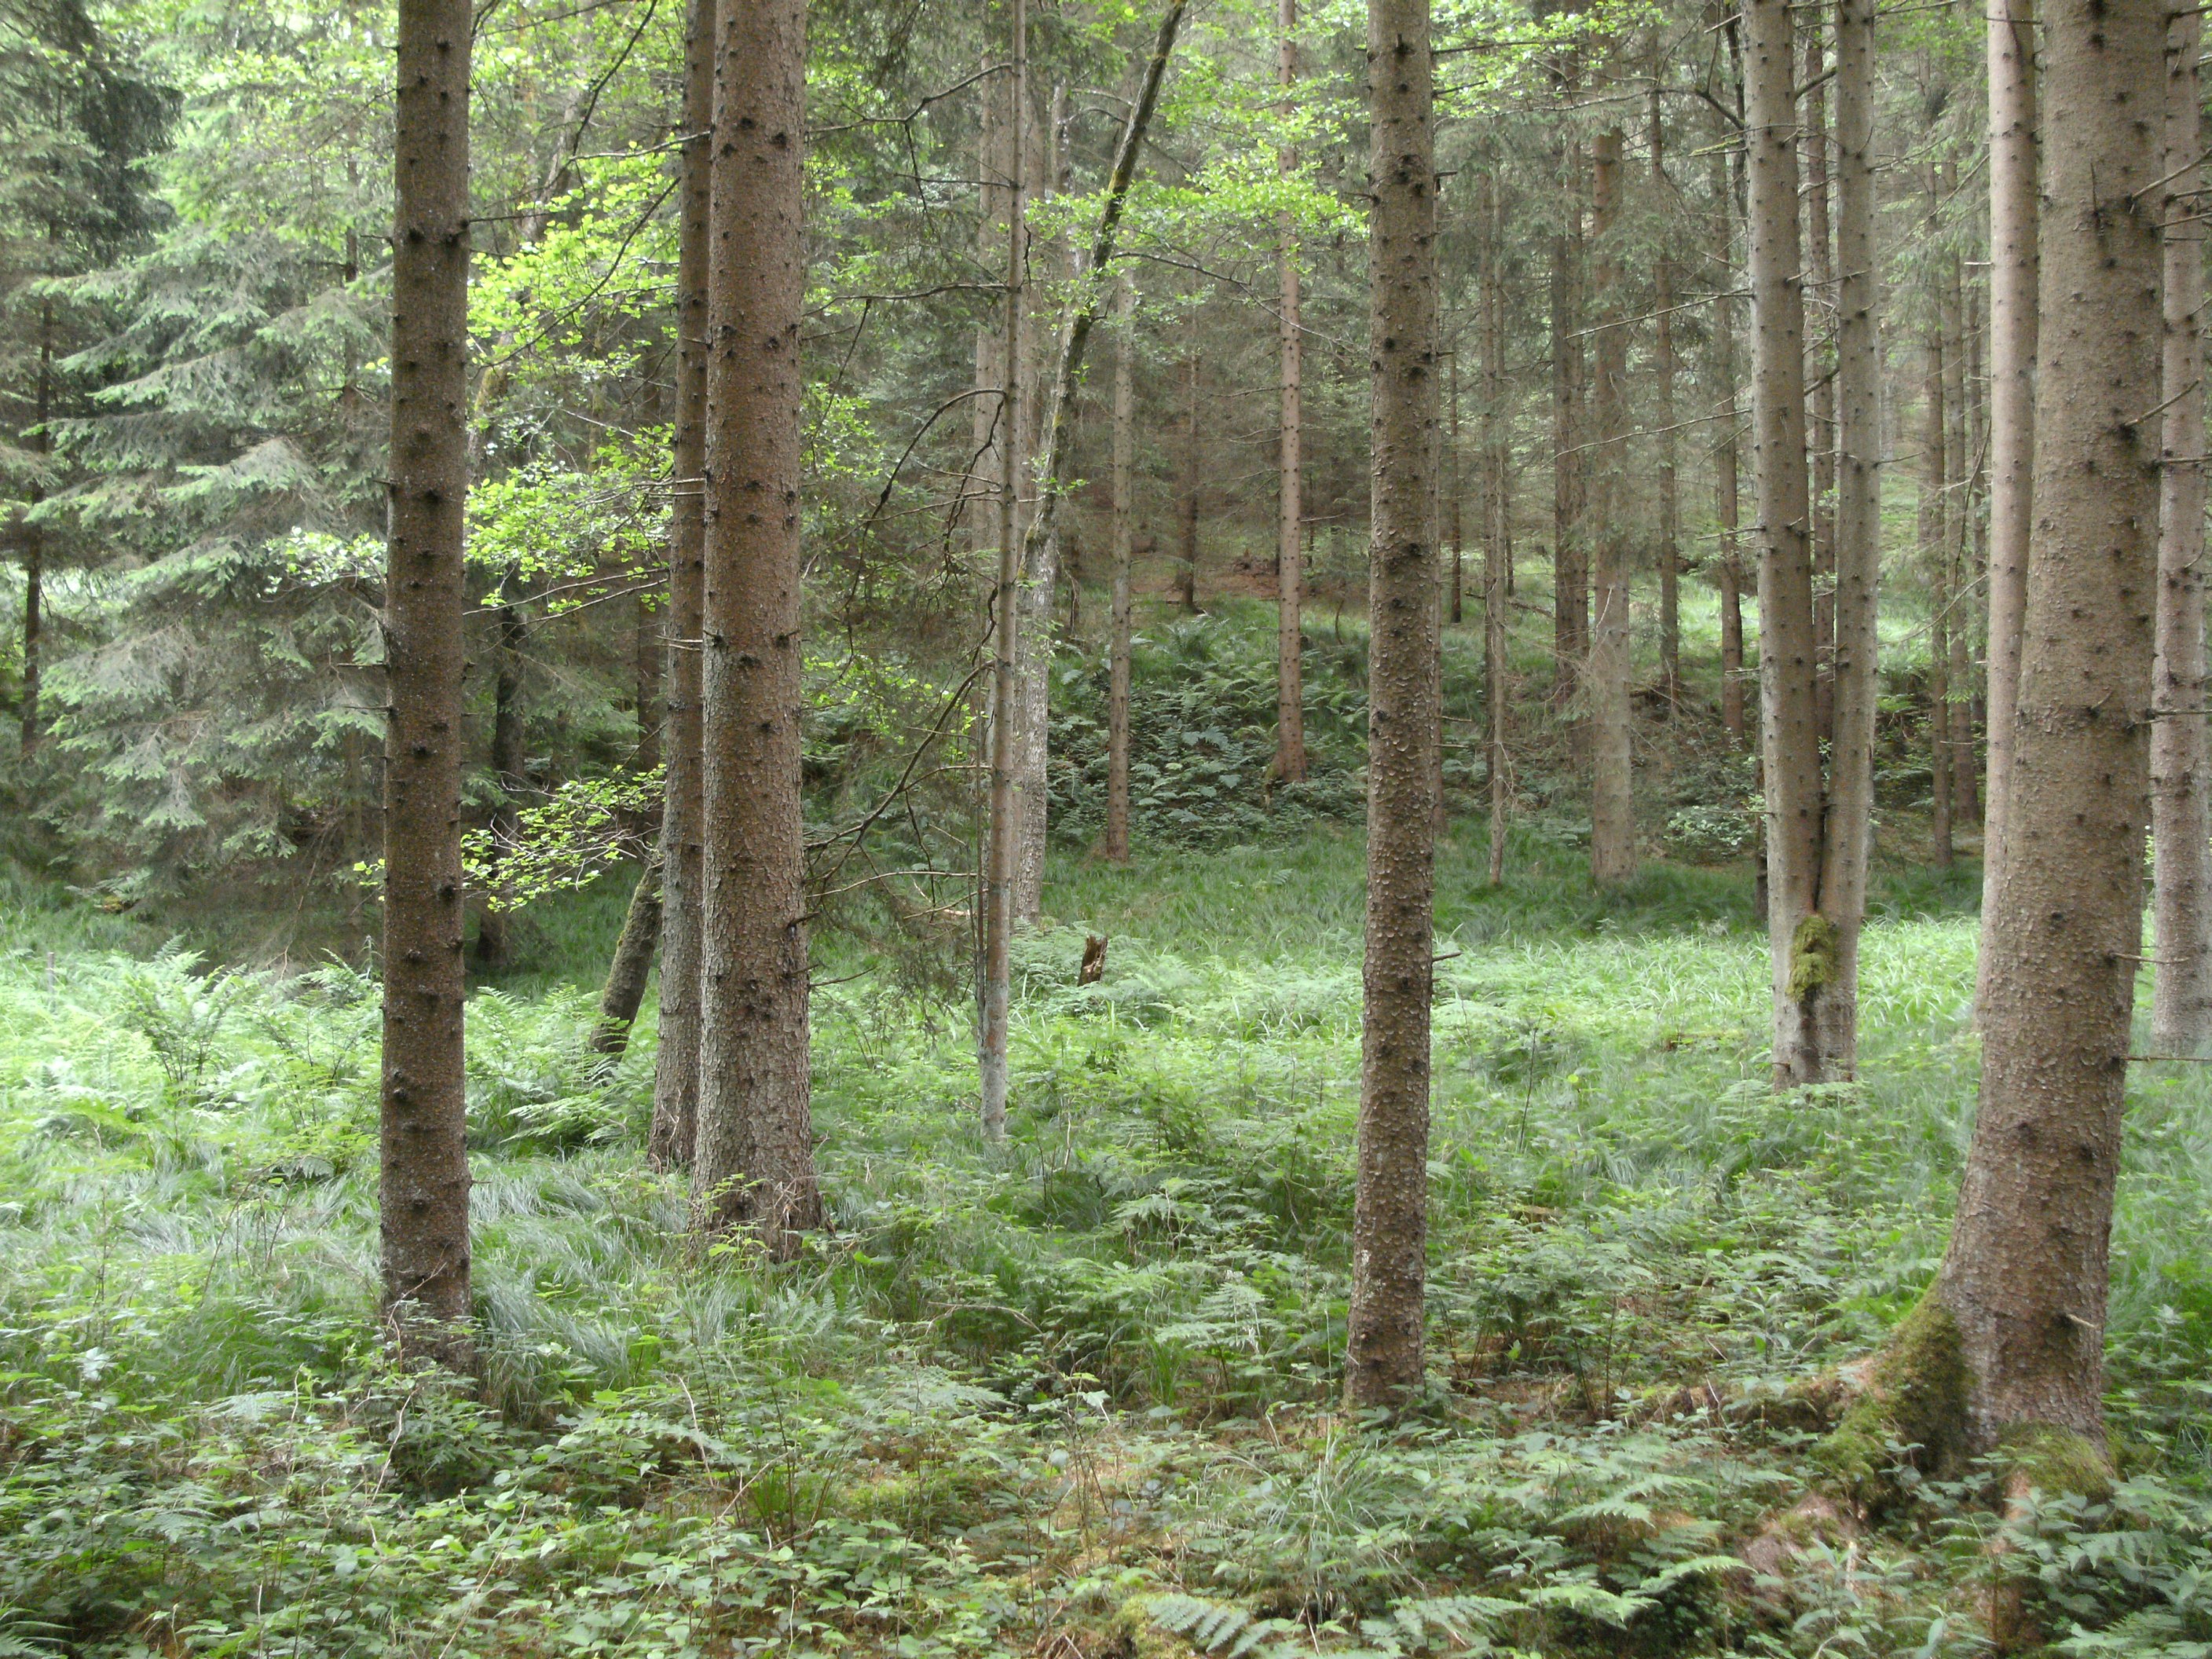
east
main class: Woodland
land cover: Spruce dominated coniferous woodland
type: hemiboreal forest and nemoral coniferous forest and mixed broadleaved-coniferous forest
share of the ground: 50 - 75 %
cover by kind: coniferous forest trees 75 %, shrubs 10 %, herbaceous plants 10 %, broadleaved forest trees 5 %
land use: Forestry
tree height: > 5 m
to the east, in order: Spruce dominated coniferous woodland; Ditches and canals; Spruce dominated mixed woodland; Spruce dominated coniferous woodland; Tracks; Other coniferous woodland; Spruce dominated coniferous woodland; Tracks; Spruce dominated coniferous woodland; Tracks; Other coniferous woodland; Shrubland with sparse tree cover; Tracks; Spruce dominated coniferous woodland
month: June
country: AT
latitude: 48.5066
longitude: 14.1285
